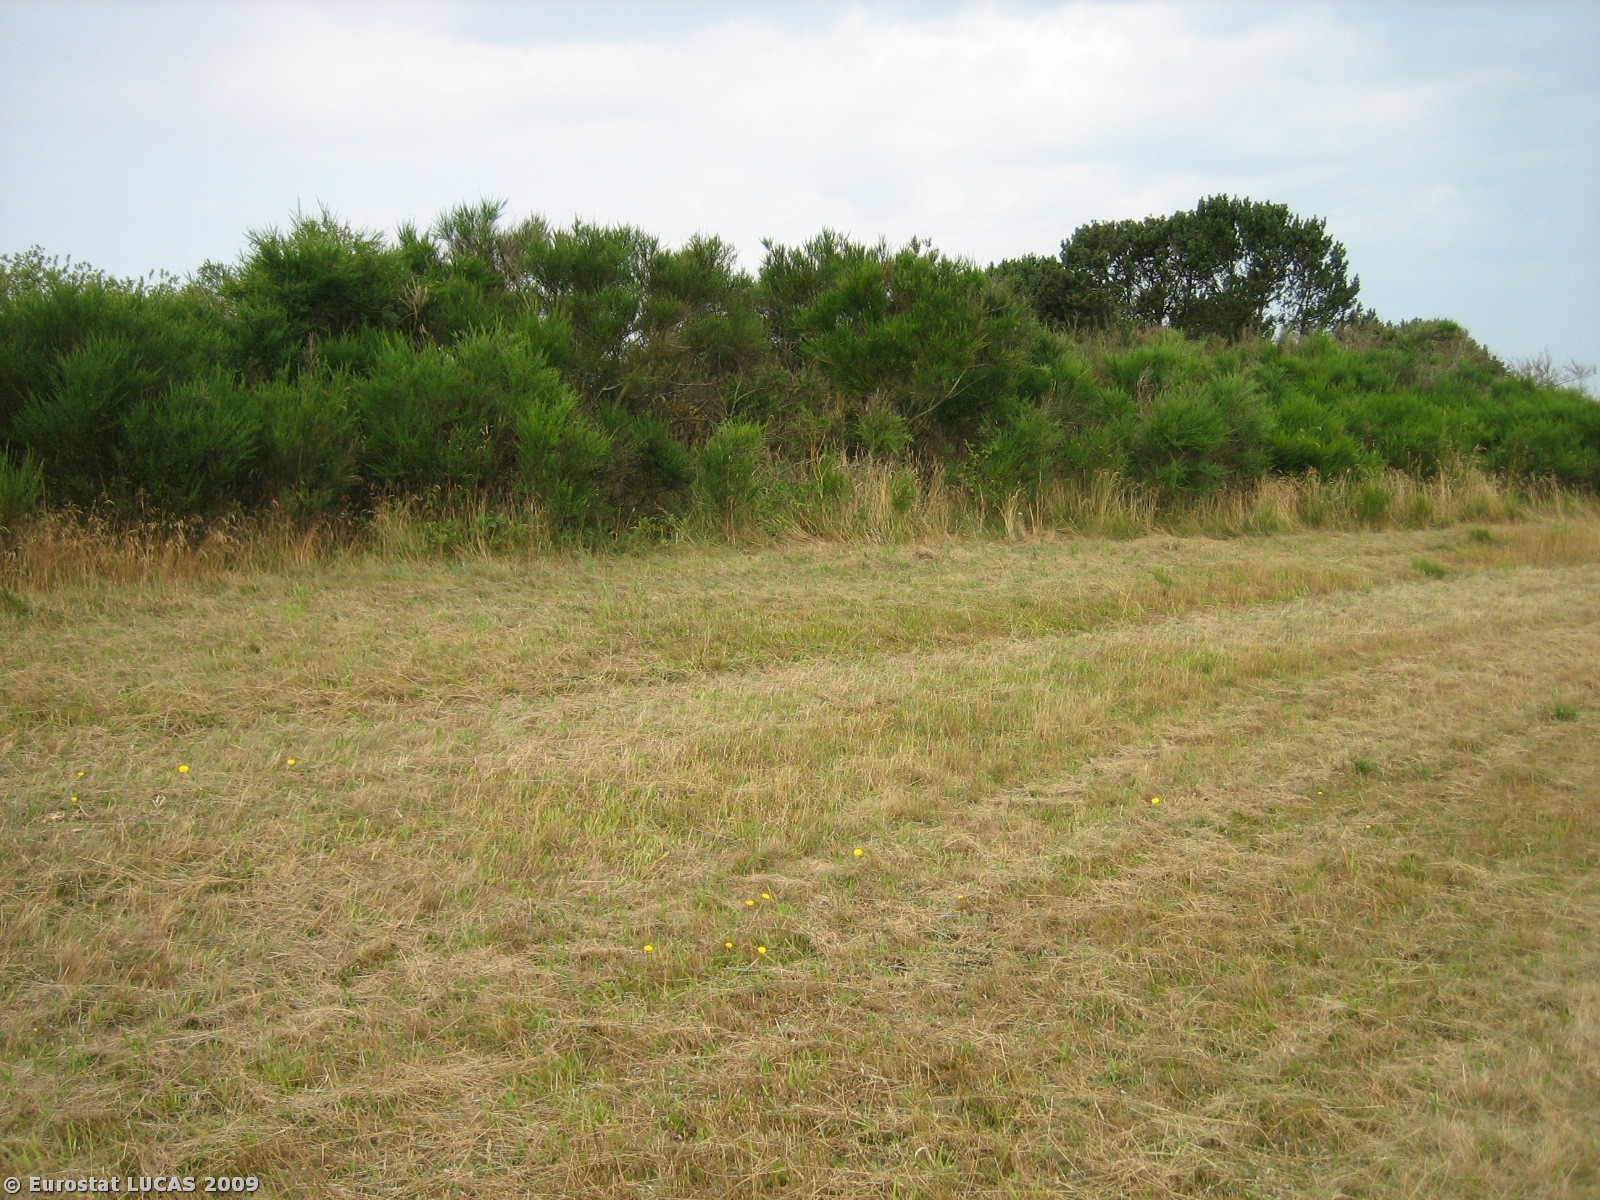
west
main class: Grassland
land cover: Grassland without tree/shrub cover
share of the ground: > 75 %
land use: Agriculture (excluding fallow land and kitchen gardens)
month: July
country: DK
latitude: 55.8724
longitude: 8.4194
